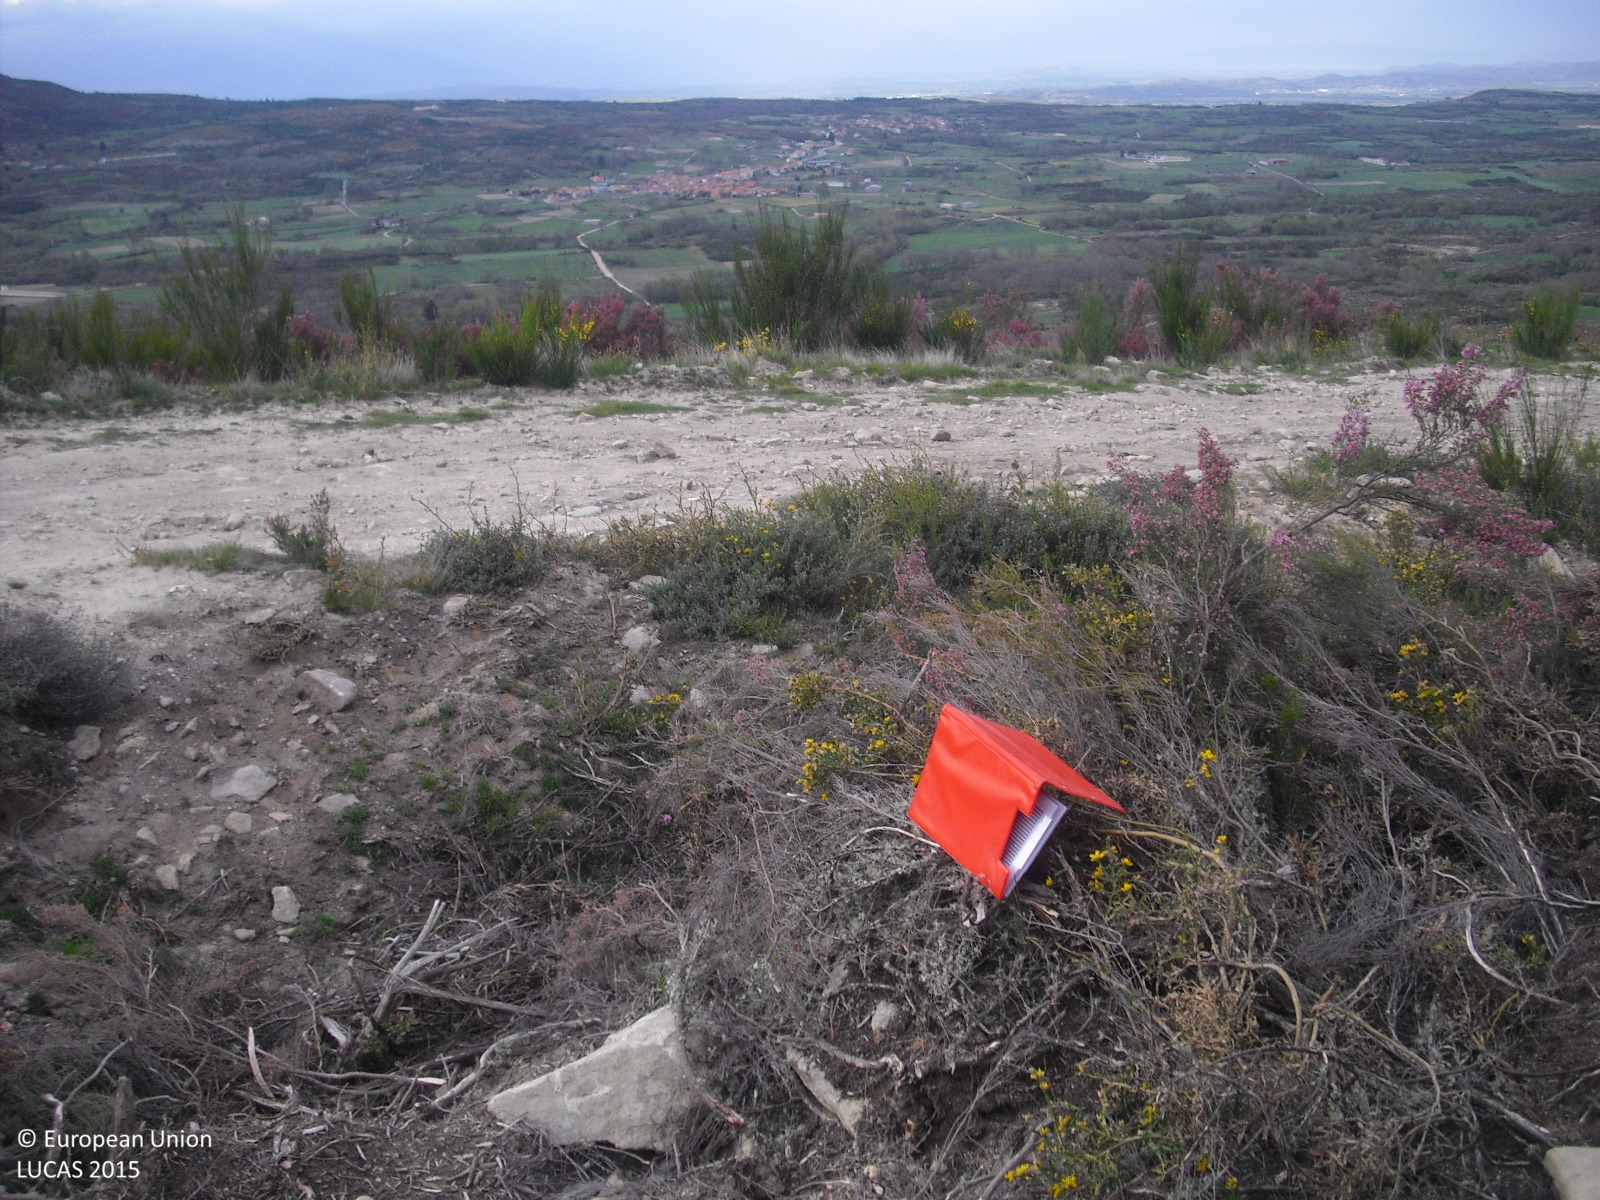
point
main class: Shrubland
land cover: Shrubland without tree cover
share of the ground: > 75 %
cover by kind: shrubs 90 %, herbaceous plants 5 %, unconsolidated bare surface 5 %
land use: Semi-natural and natural areas not in use
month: April
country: ES
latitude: 41.9272
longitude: -7.7095
